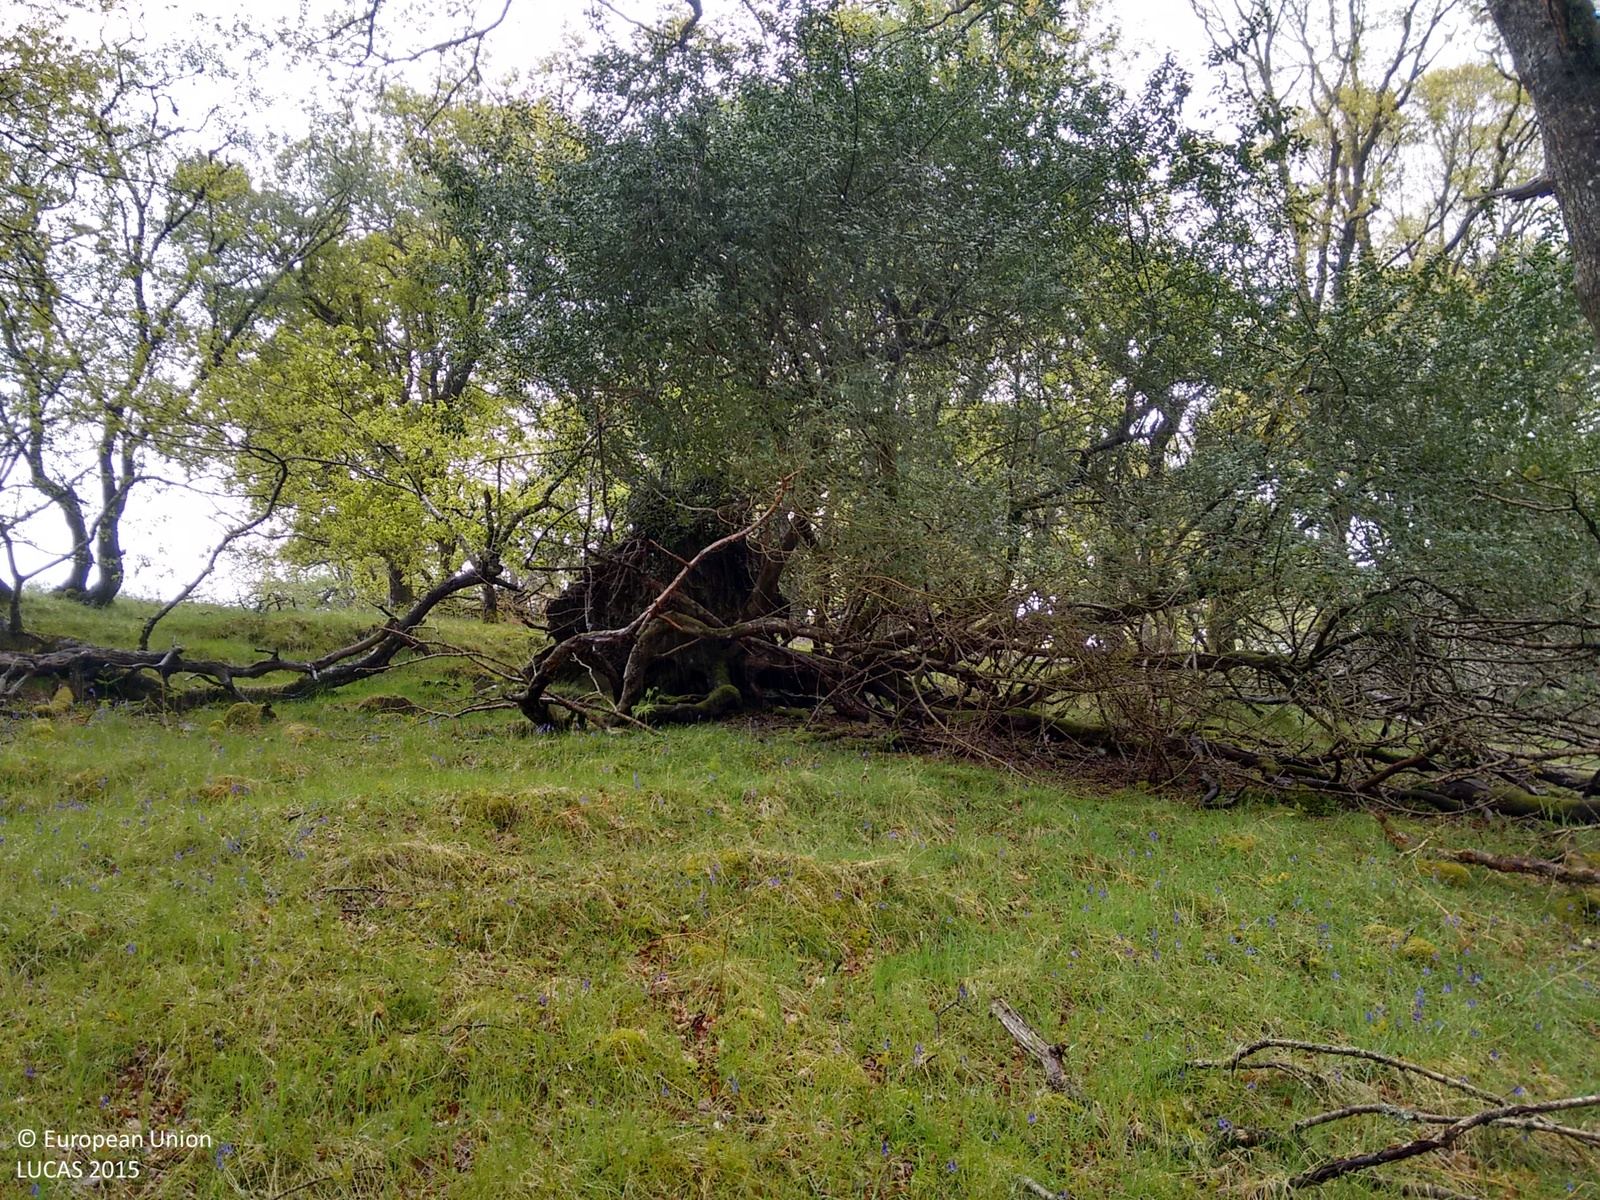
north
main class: Woodland
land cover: Broadleaved woodland
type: acidophilous oak and oak-birch forest
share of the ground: > 75 %
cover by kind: broadleaved forest trees 100 %
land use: Semi-natural and natural areas not in use
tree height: > 5 m
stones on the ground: 10 - 25 %
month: June
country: GB
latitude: 56.1548
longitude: -5.1990
